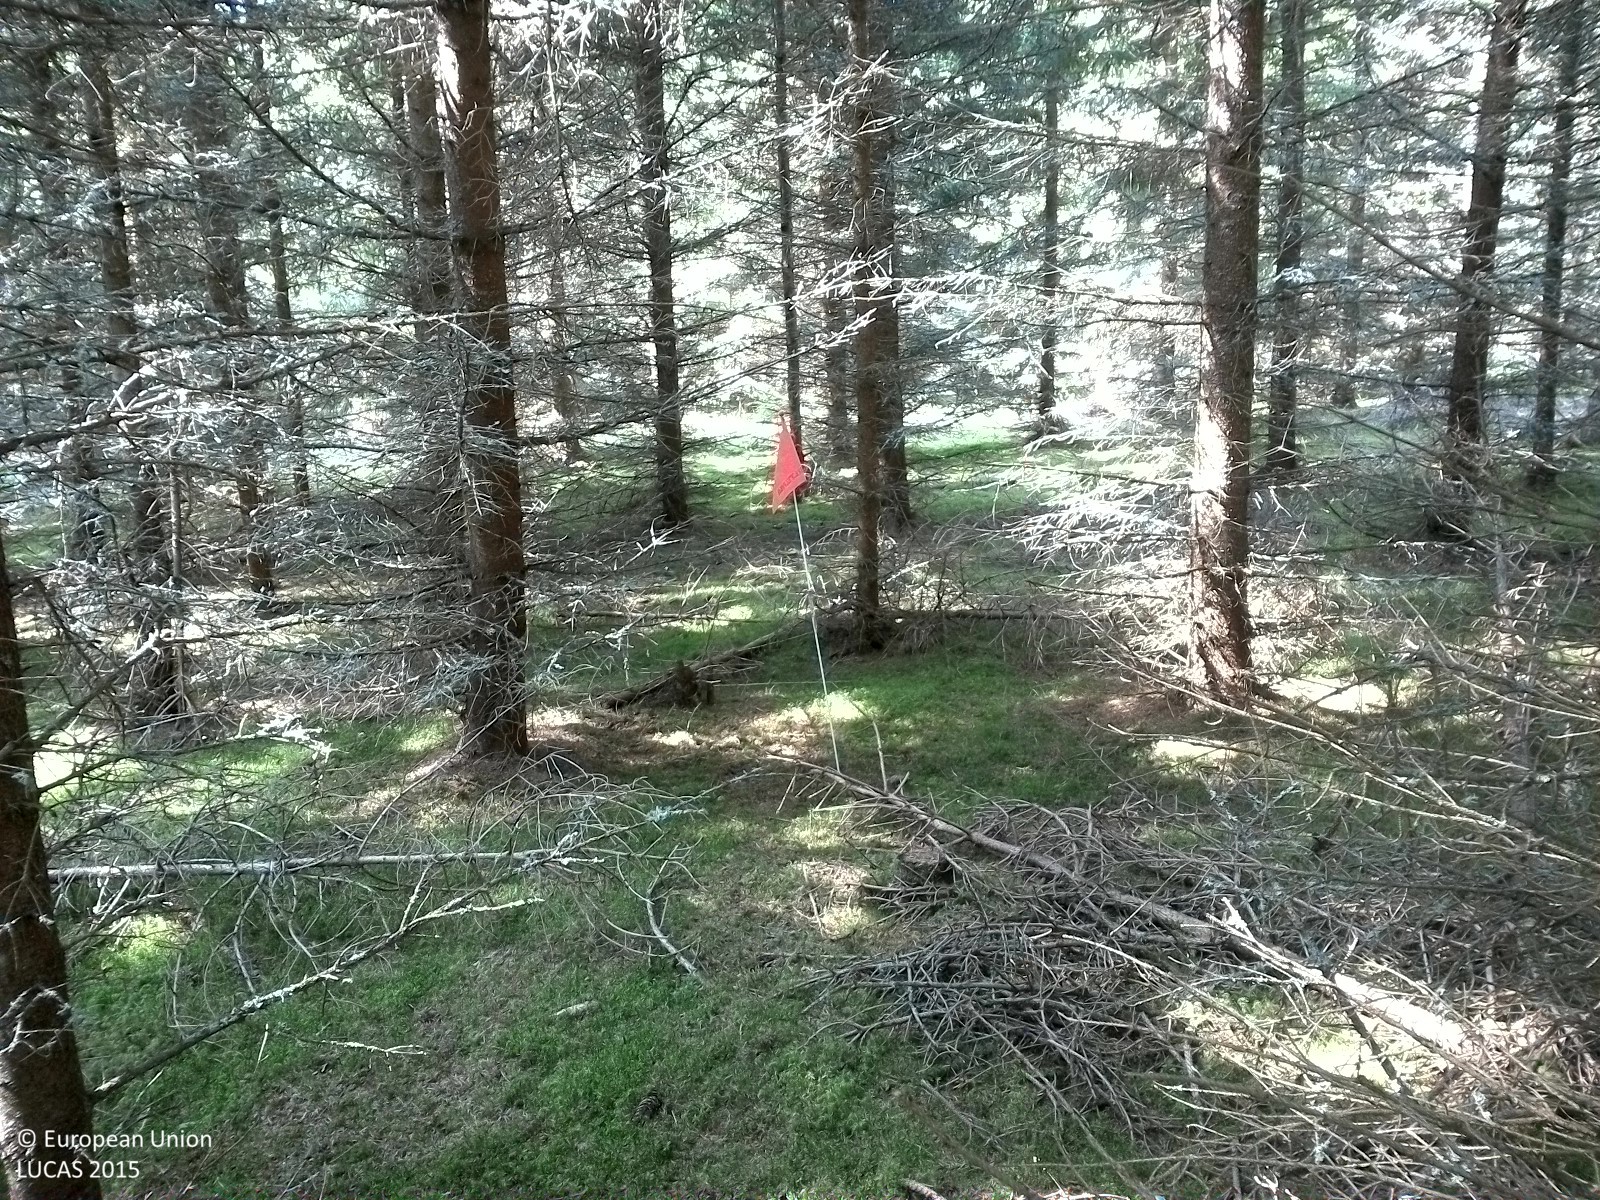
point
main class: Woodland
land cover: Spruce dominated coniferous woodland
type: boreal forest
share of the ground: 50 - 75 %
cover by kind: coniferous forest trees 70 %, lichens and mosses 30 %
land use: Forestry
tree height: > 5 m
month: August
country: SE
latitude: 58.7387
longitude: 15.0206
